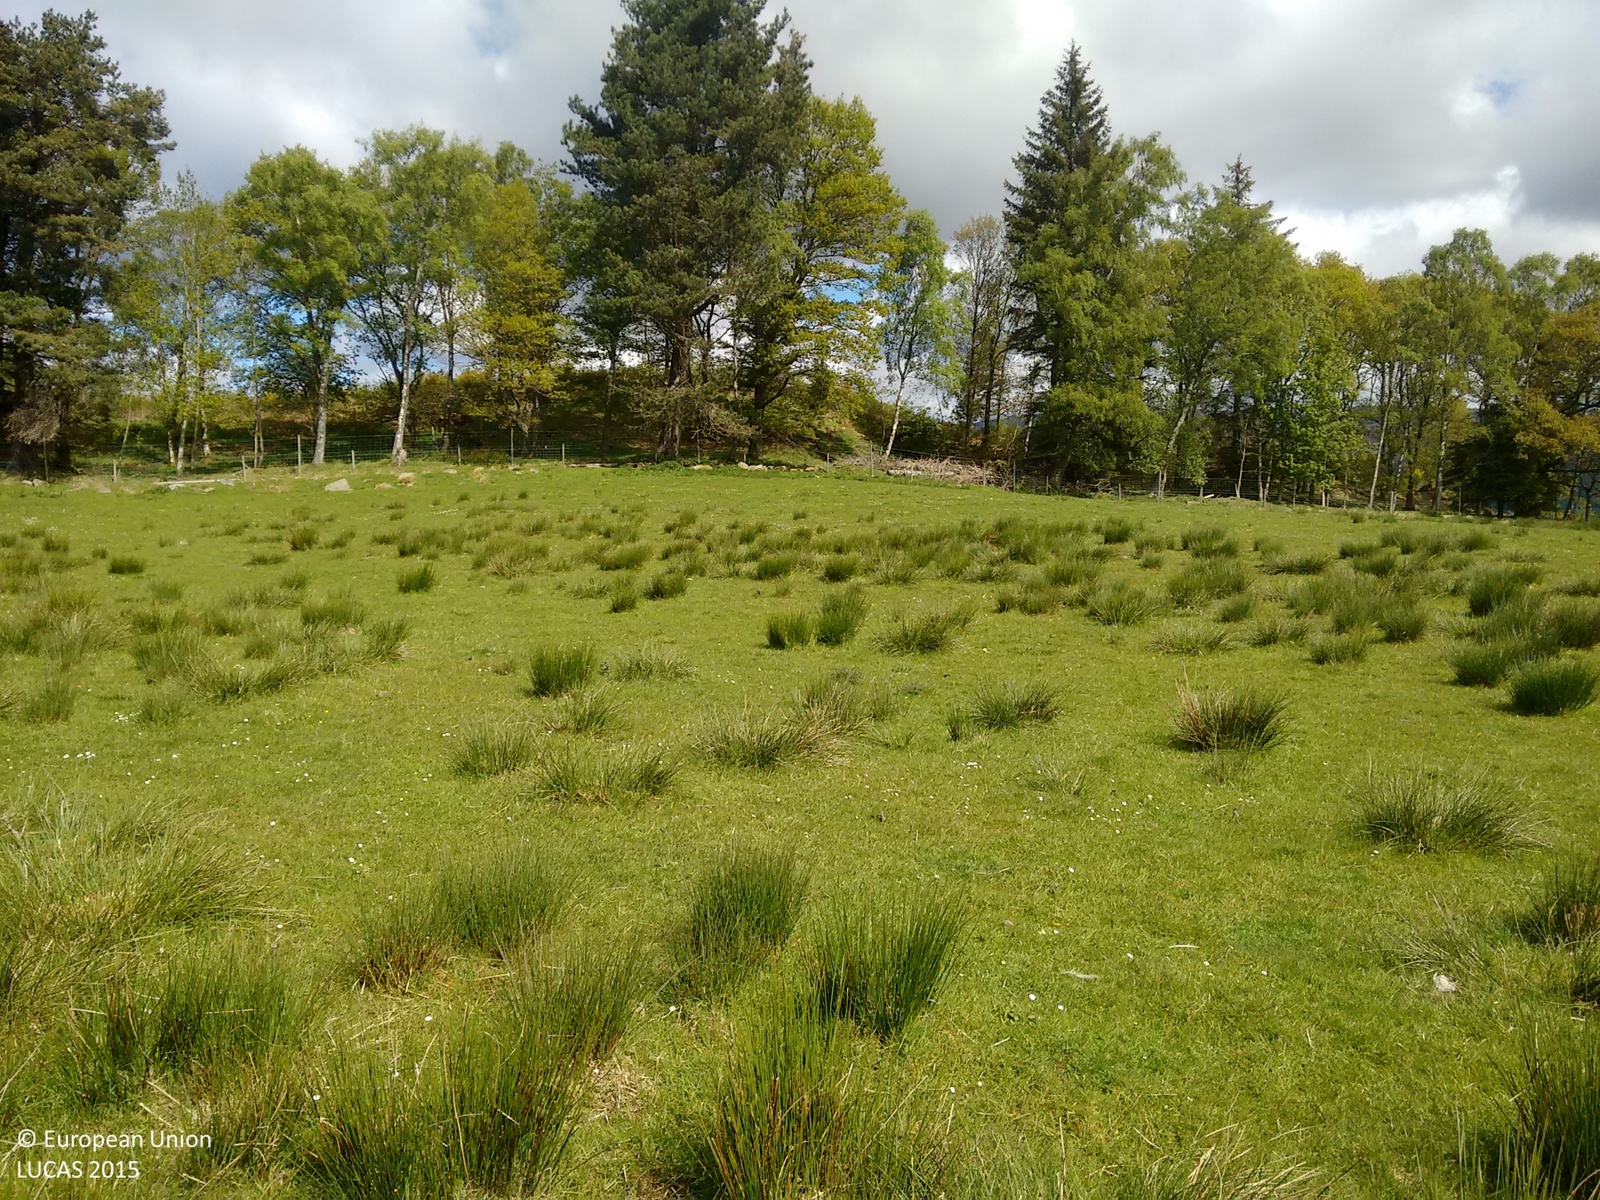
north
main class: Grassland
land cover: Grassland without tree/shrub cover
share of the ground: > 75 %
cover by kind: herbaceous plants 100 %
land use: Agriculture (excluding fallow land and kitchen gardens)
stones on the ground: < 10 %
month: May
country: GB
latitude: 56.3491
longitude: -3.9850
